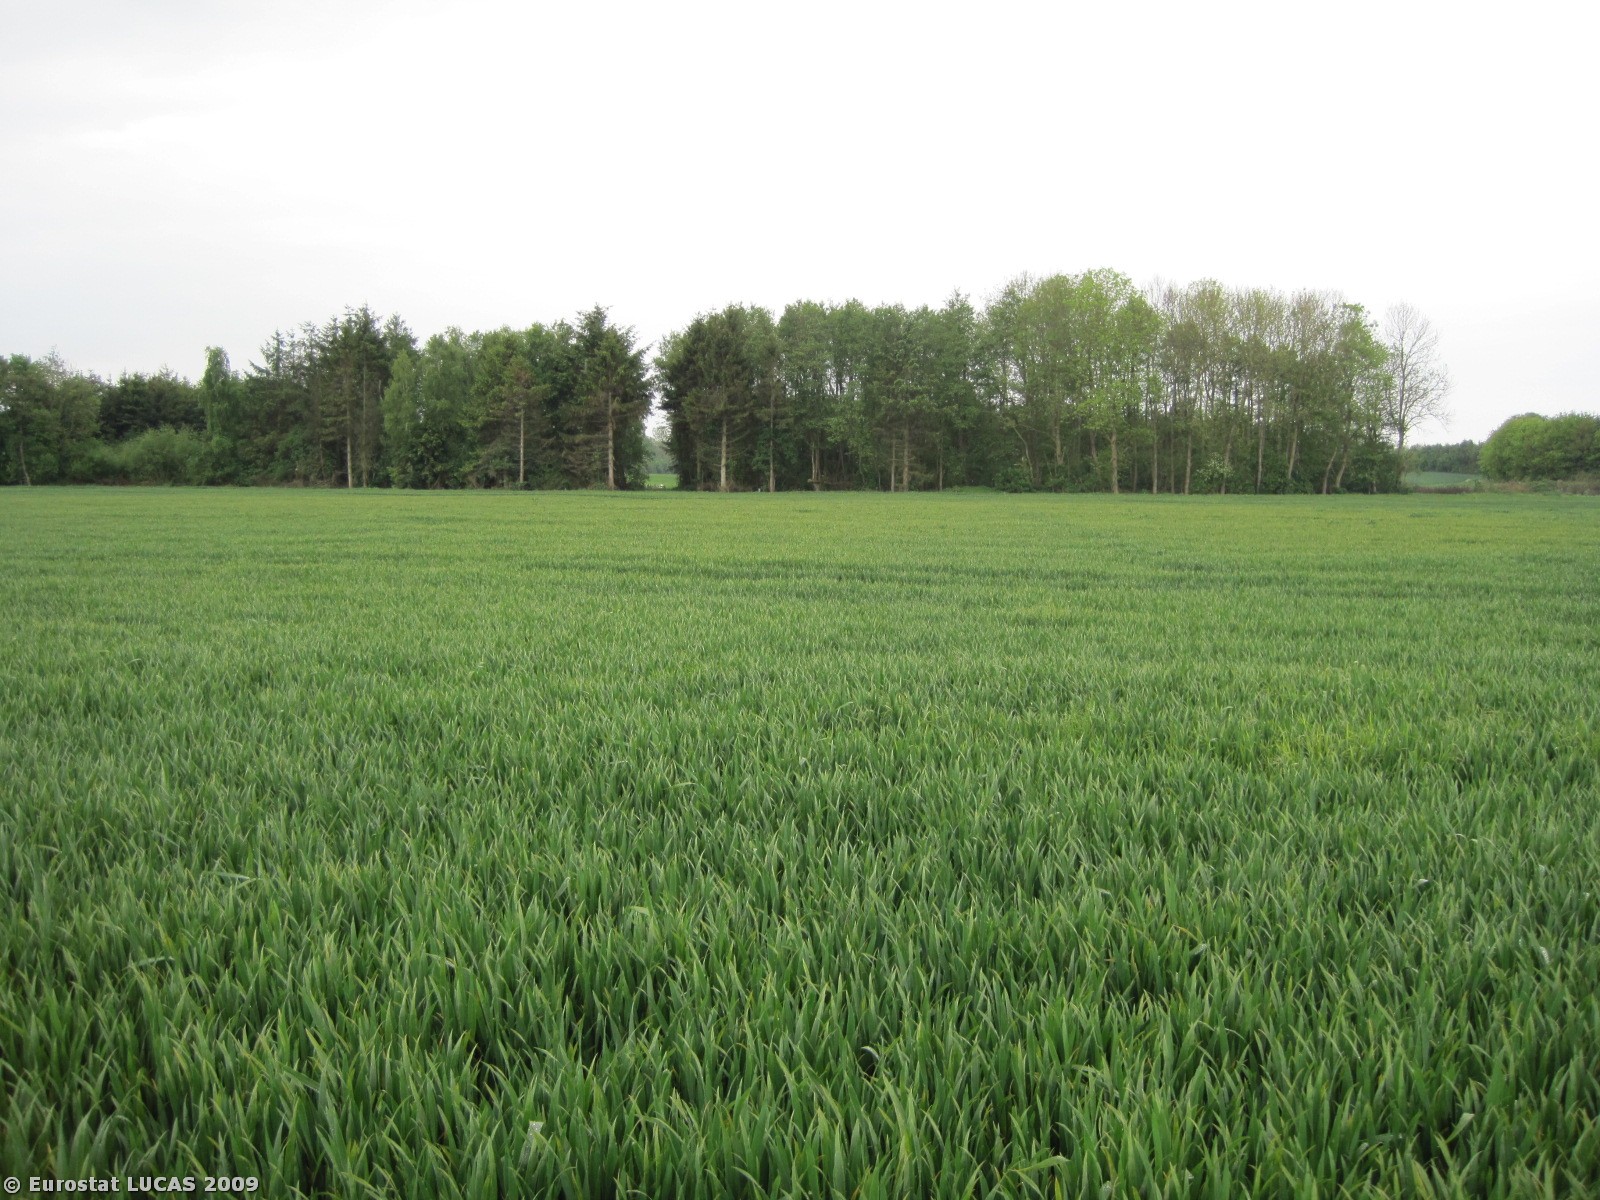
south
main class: Cropland
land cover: Common wheat
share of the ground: > 75 %
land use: Agriculture (excluding fallow land and kitchen gardens)
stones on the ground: < 10 %
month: May
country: DK
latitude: 56.7629
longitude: 10.1470
